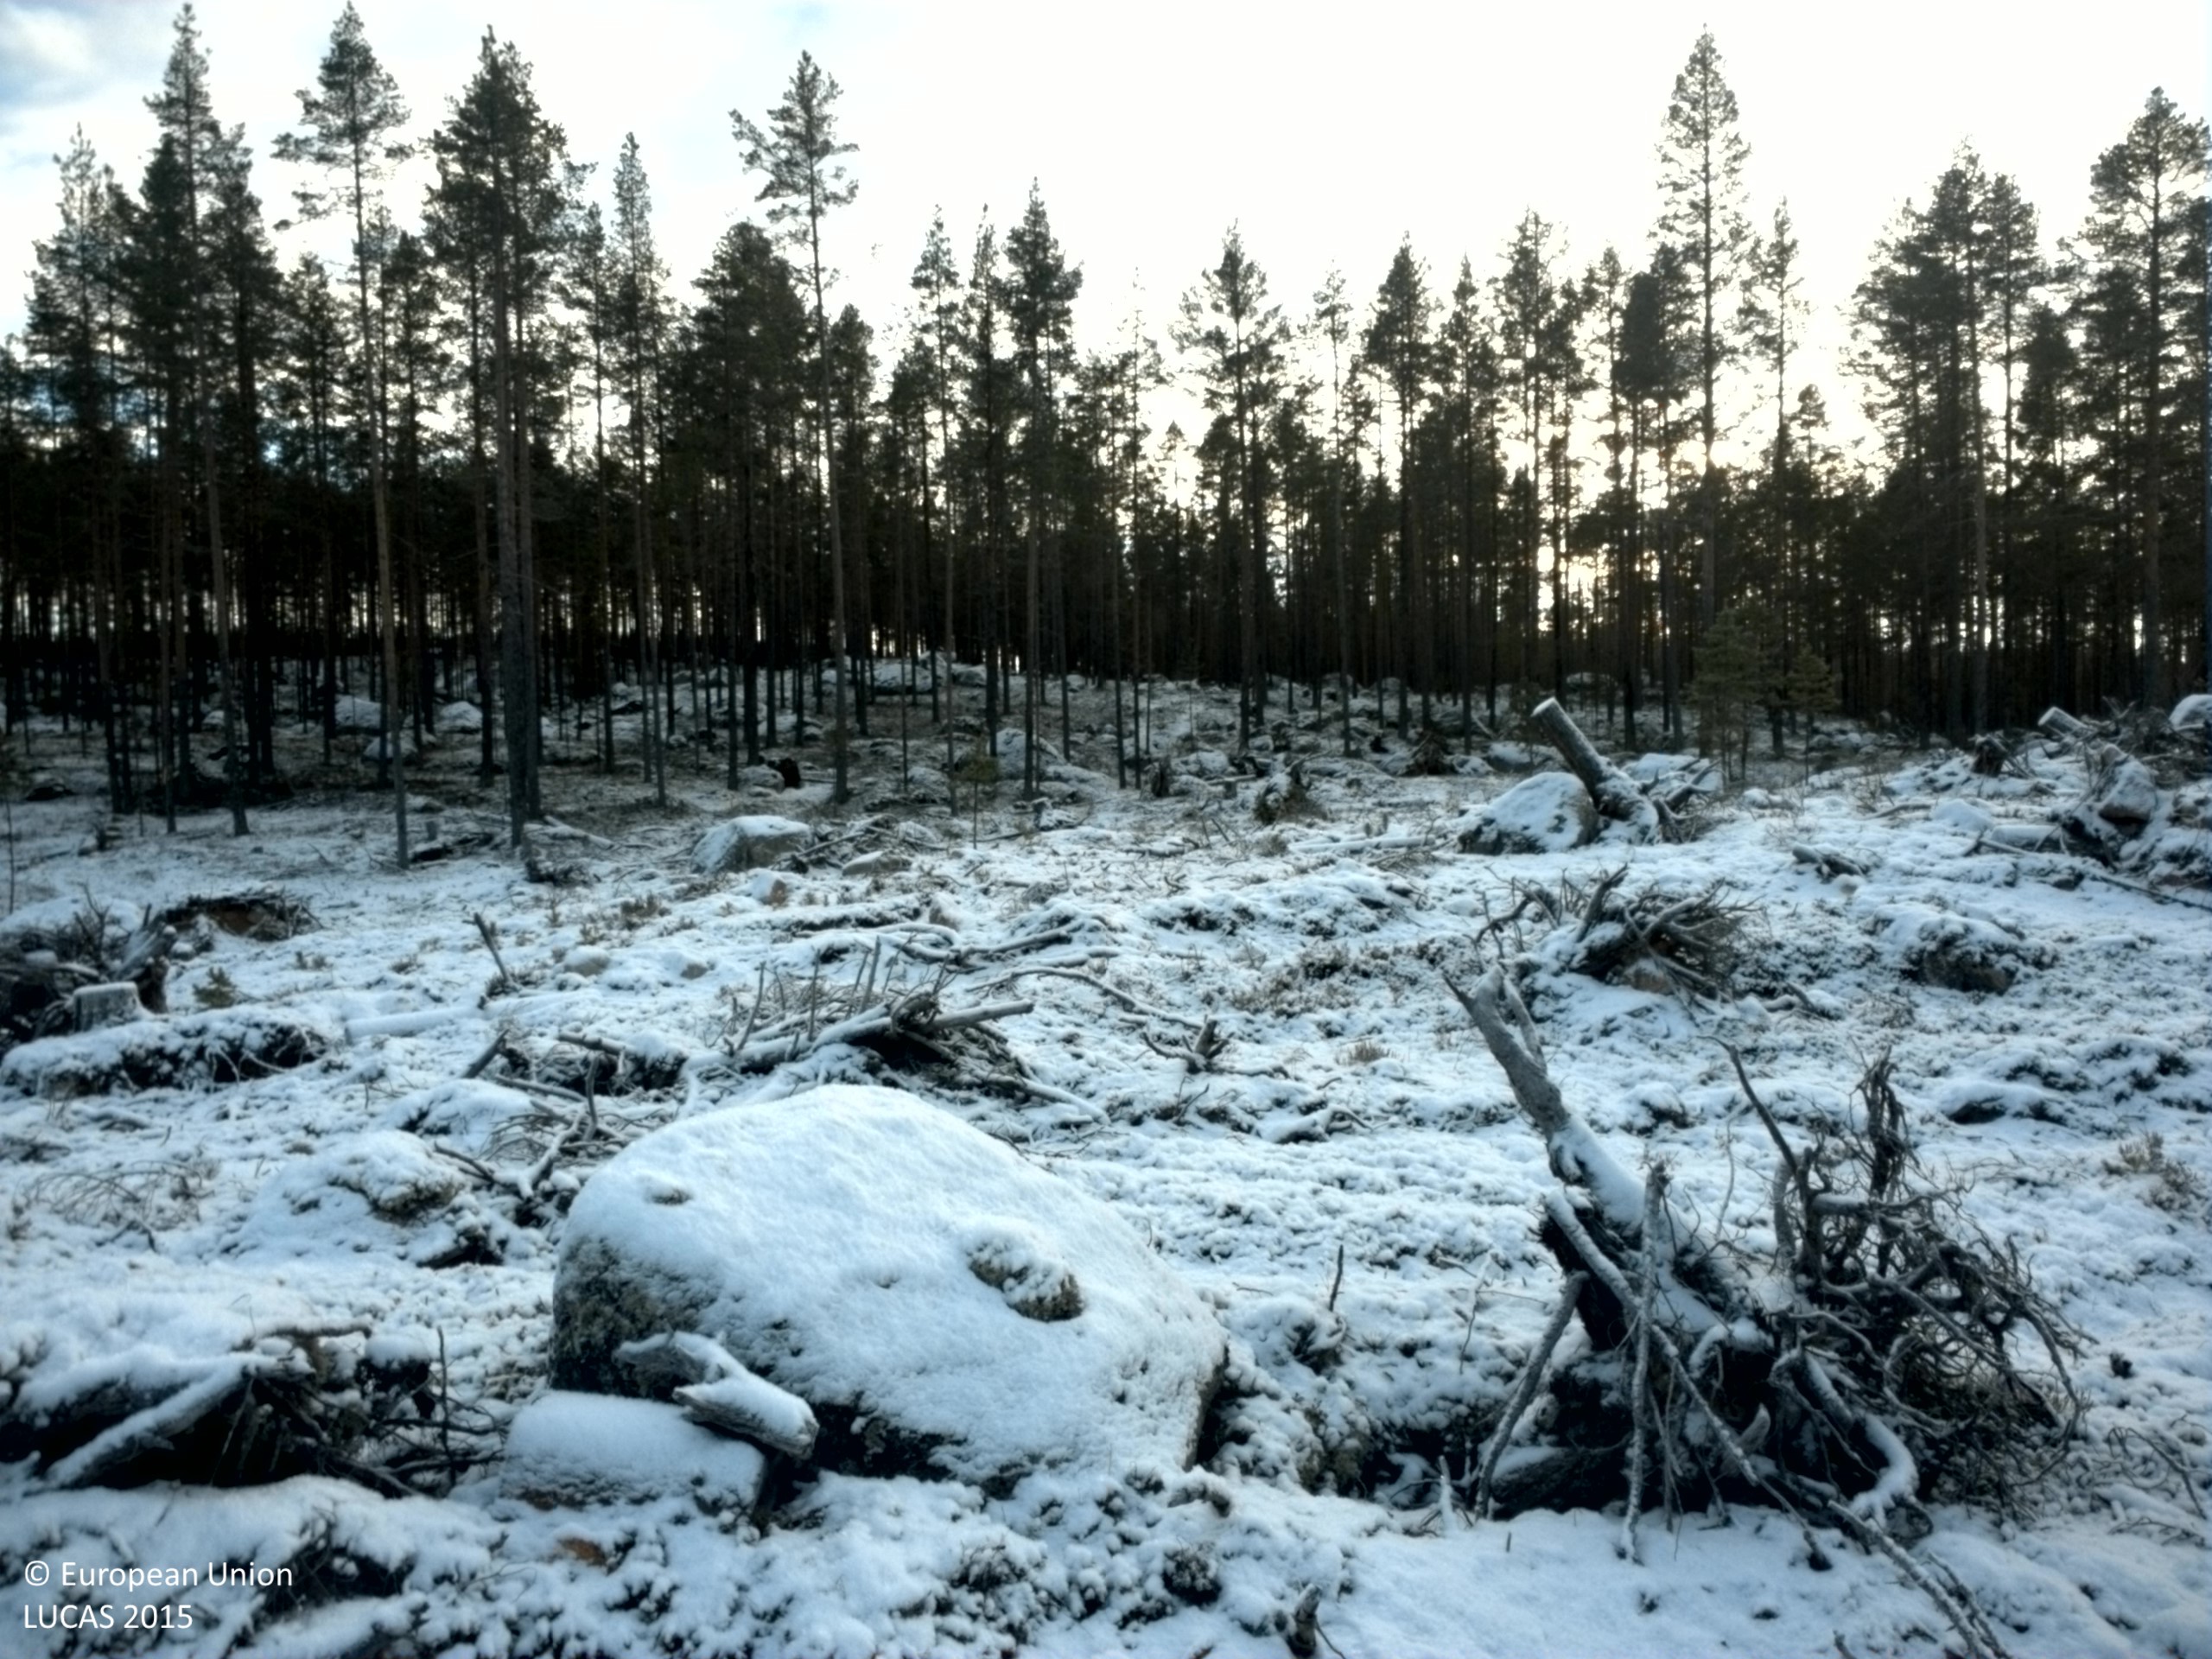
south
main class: Shrubland
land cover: Shrubland with sparse tree cover
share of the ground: 25 - 50 %
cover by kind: lichens and mosses 40 %, shrubs 35 %, consolidated bare surface 10 %, unconsolidated bare surface 10 %, coniferous forest trees 5 %
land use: Forestry
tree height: < 5 m
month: November
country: SE
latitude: 61.9781
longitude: 15.2674
